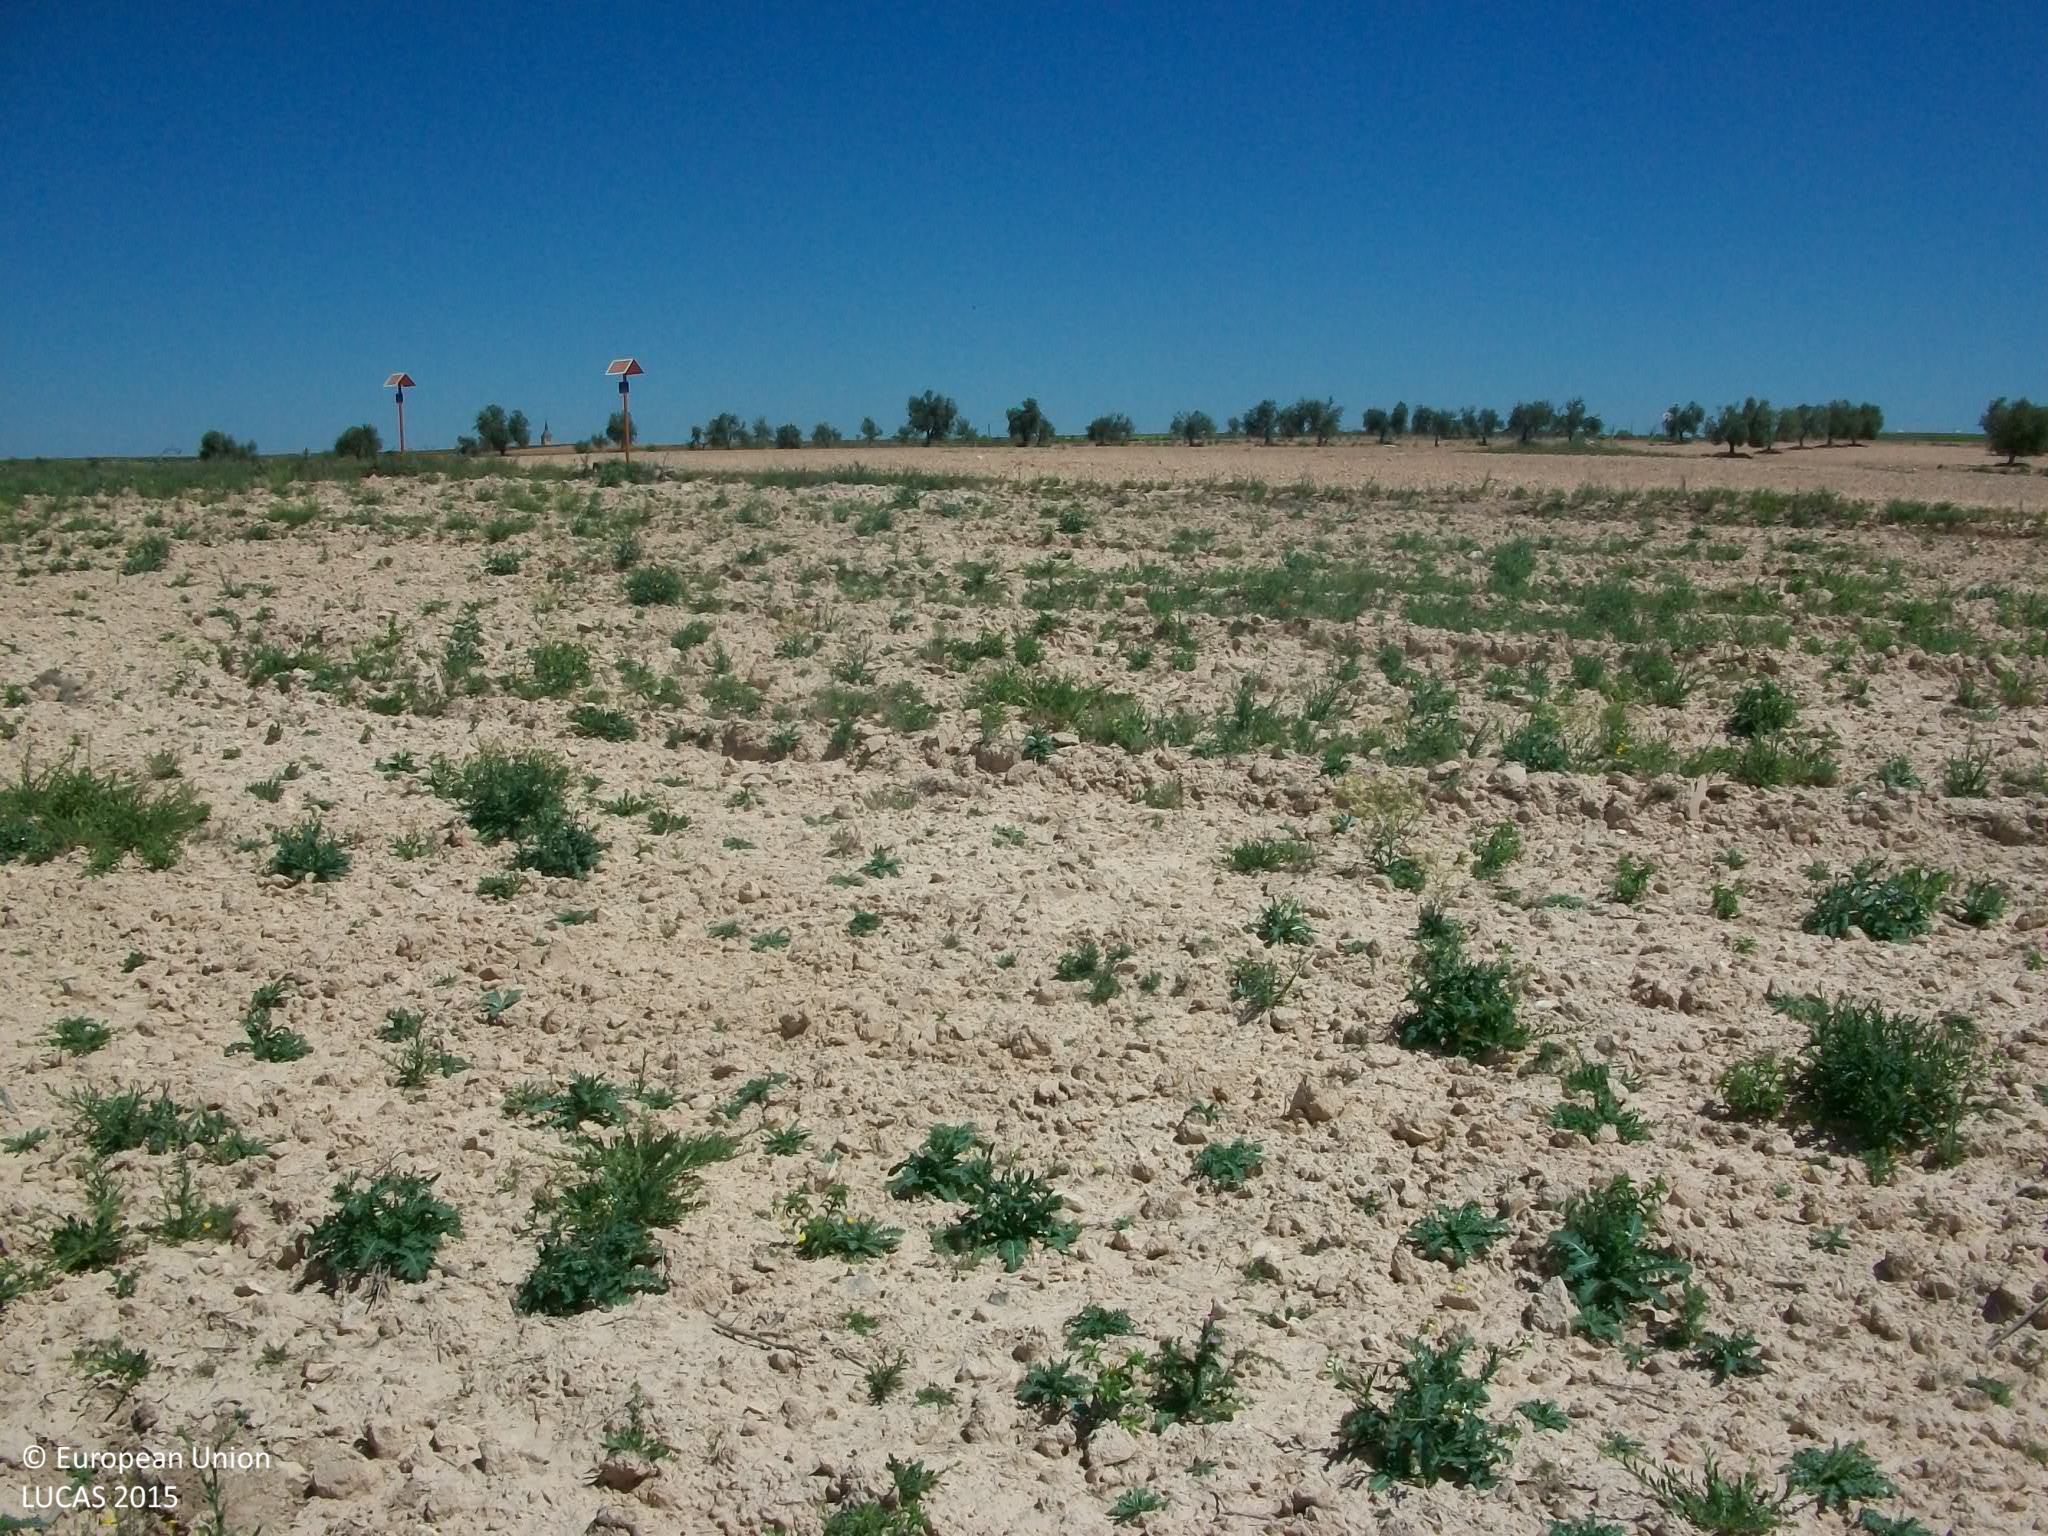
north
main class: Grassland
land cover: Spontaneously vegetated surfaces
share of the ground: 25 - 50 %
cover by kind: unconsolidated bare surface 70 %, herbaceous plants 30 %
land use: Fallow land
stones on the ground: 10 - 25 %
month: May
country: ES
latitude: 39.8794
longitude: -3.6281
